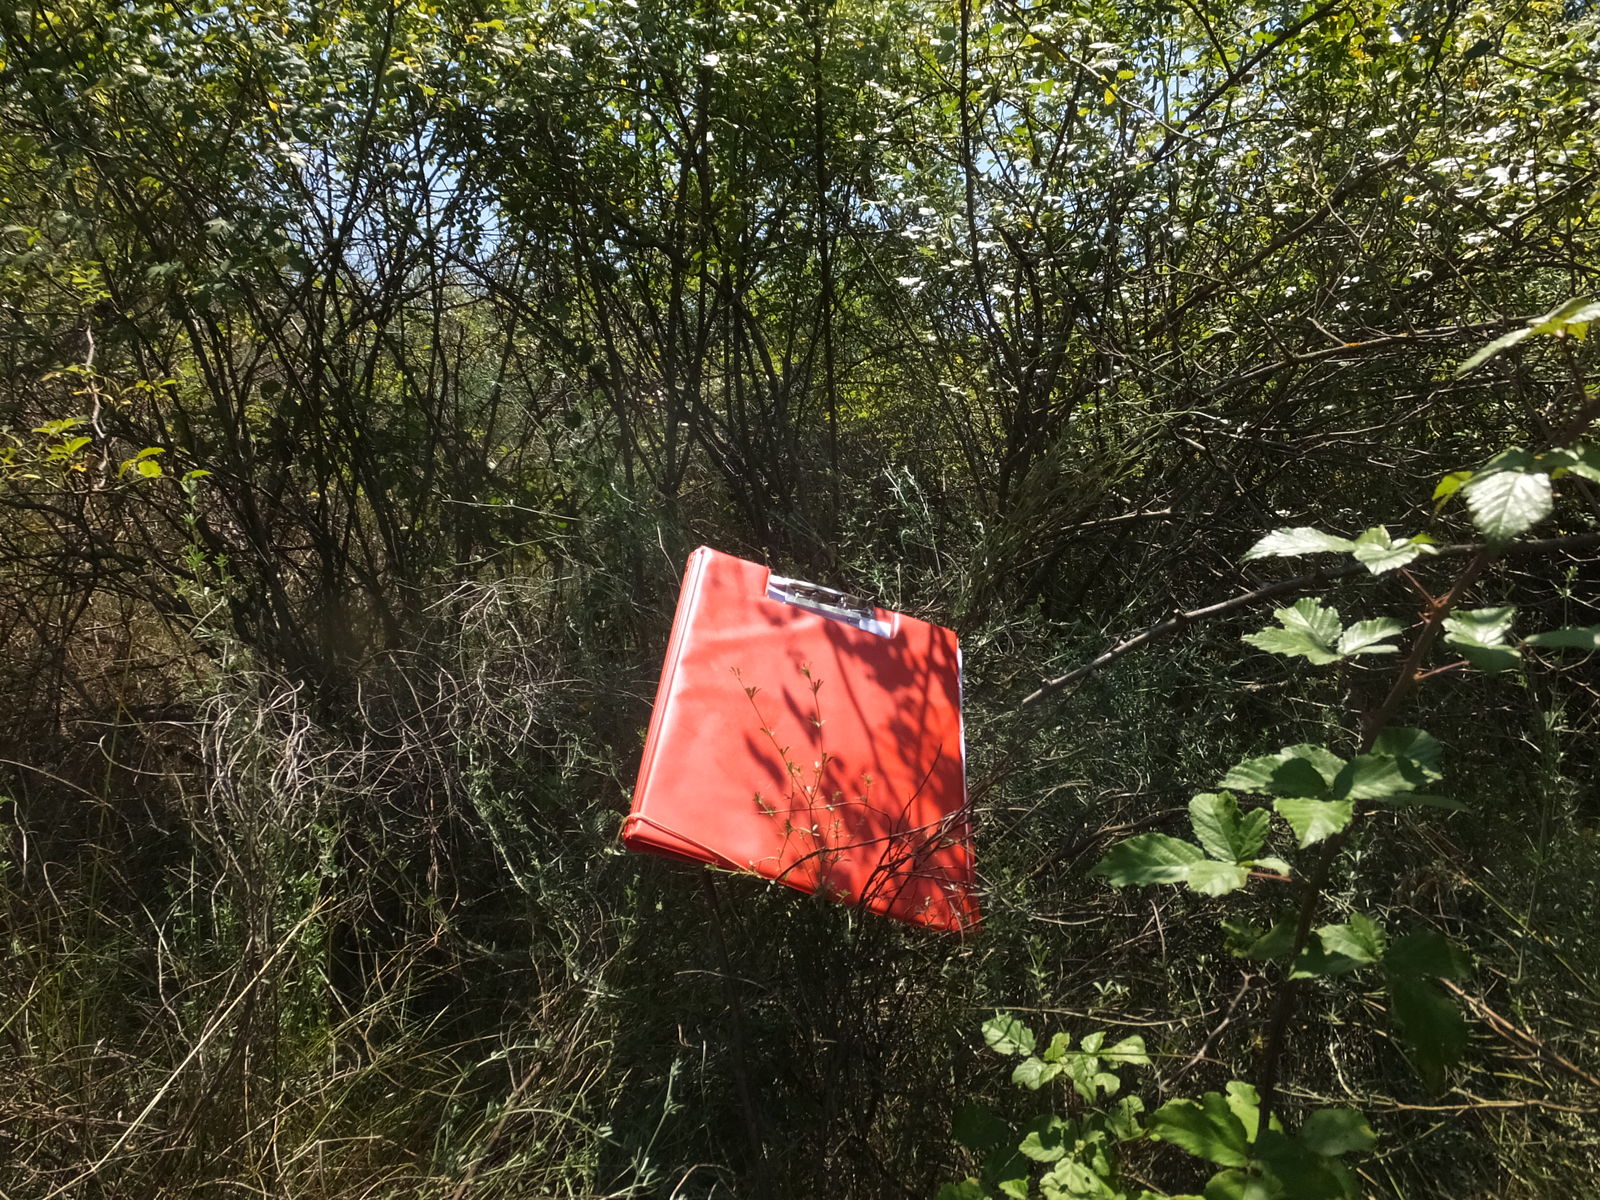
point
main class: Shrubland
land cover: Shrubland with sparse tree cover
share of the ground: 50 - 75 %
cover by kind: shrubs 70 %, herbaceous plants 25 %, broadleaved forest trees 5 %
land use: Semi-natural and natural areas not in use
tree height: < 5 m
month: June
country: ES
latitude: 41.9043
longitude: 0.5704
